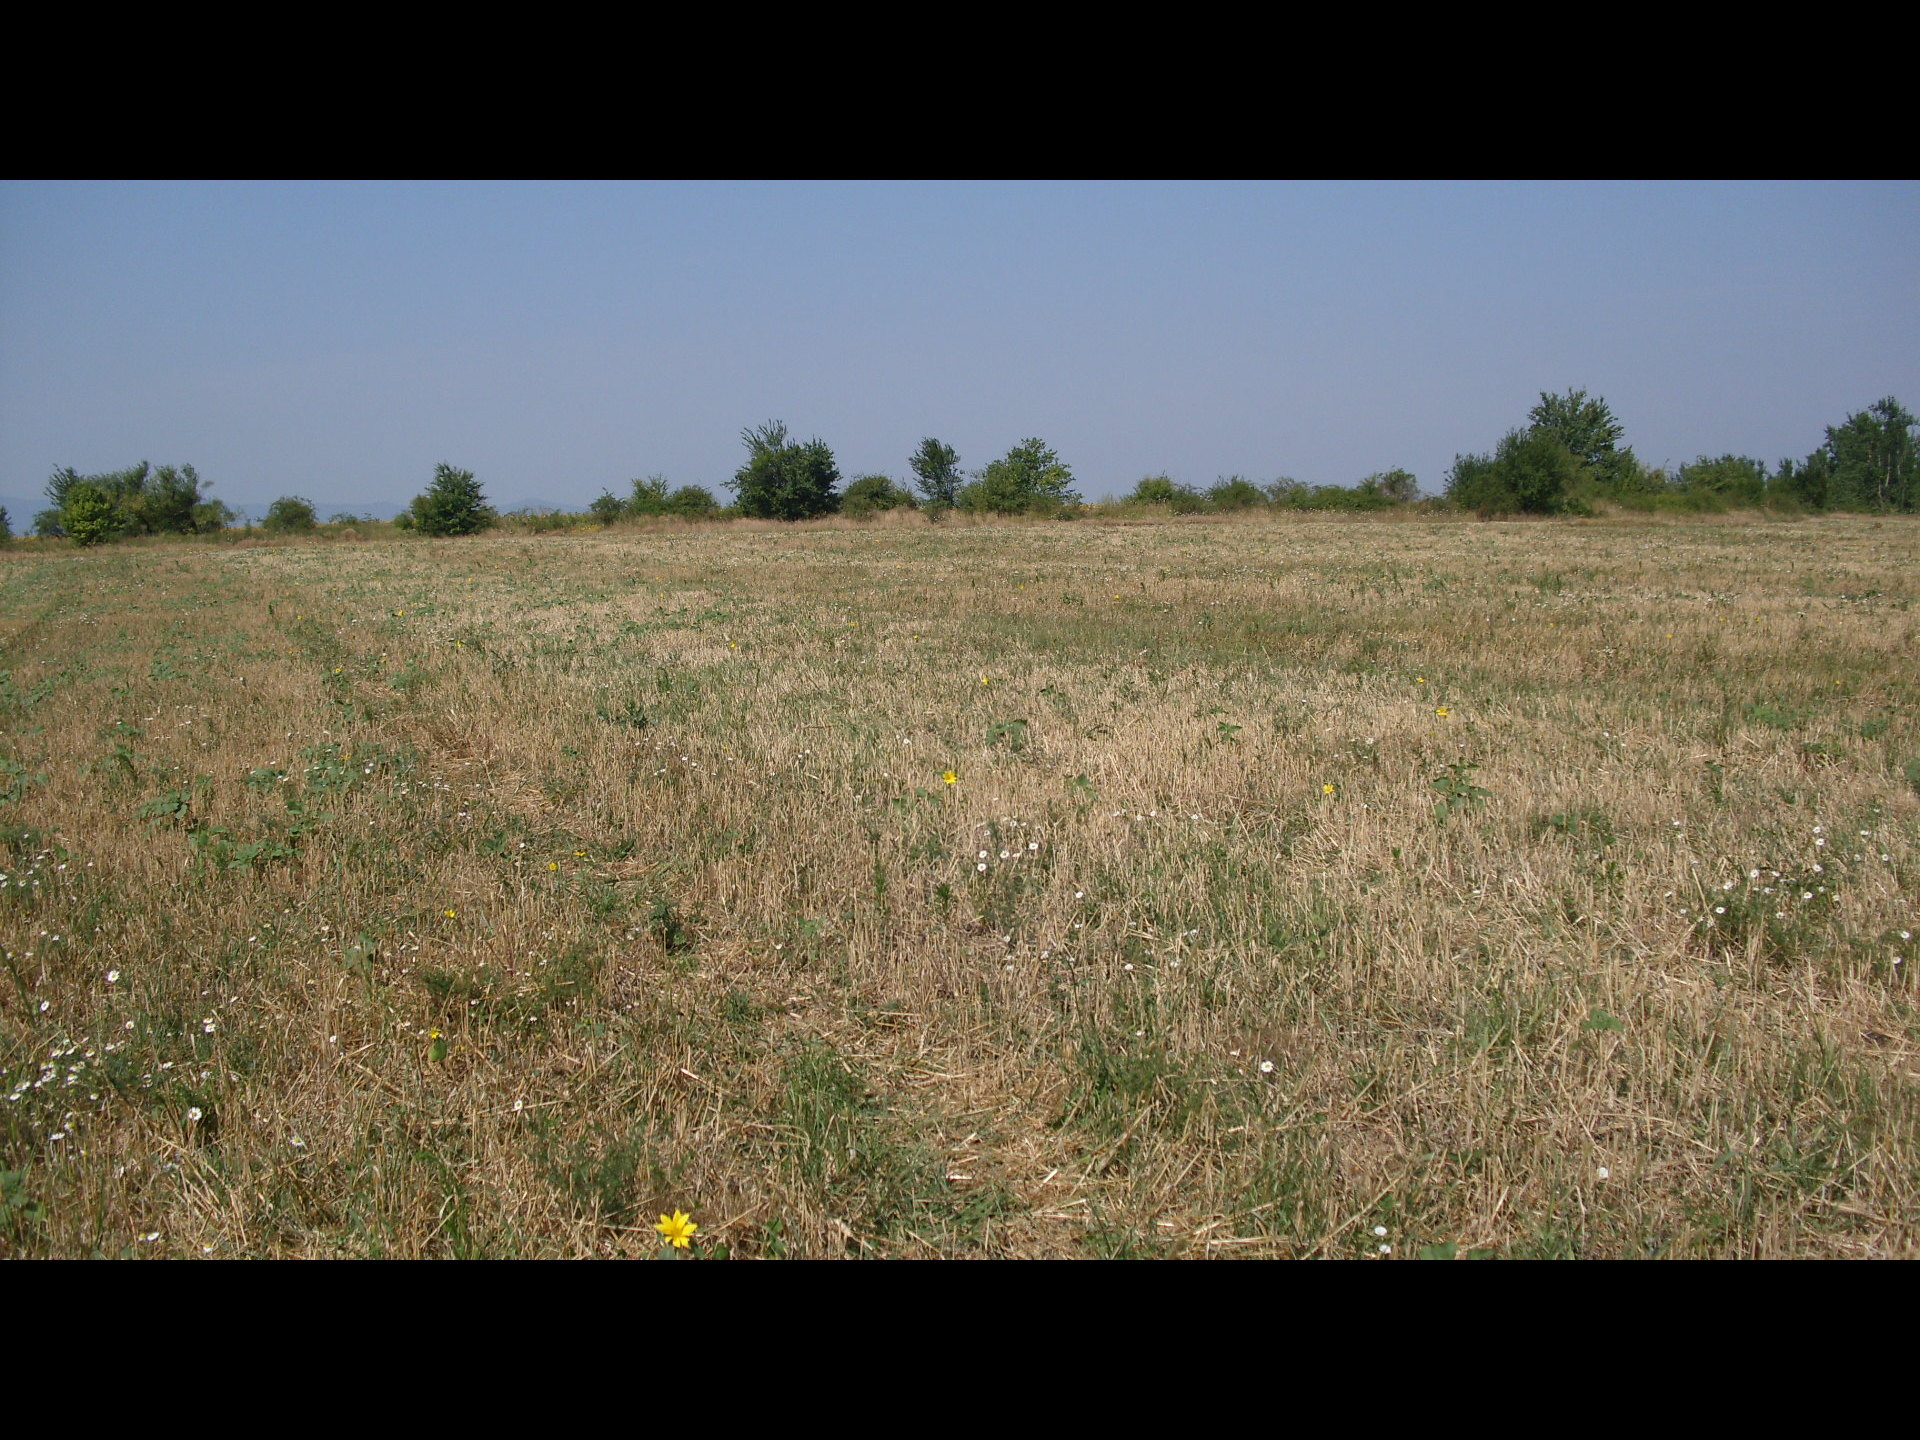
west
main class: Cropland
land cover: Common wheat
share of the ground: 50 - 75 %
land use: Agriculture (excluding fallow land and kitchen gardens)
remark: Harvested field
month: July
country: BG
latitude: 43.8097
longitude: 22.6527
